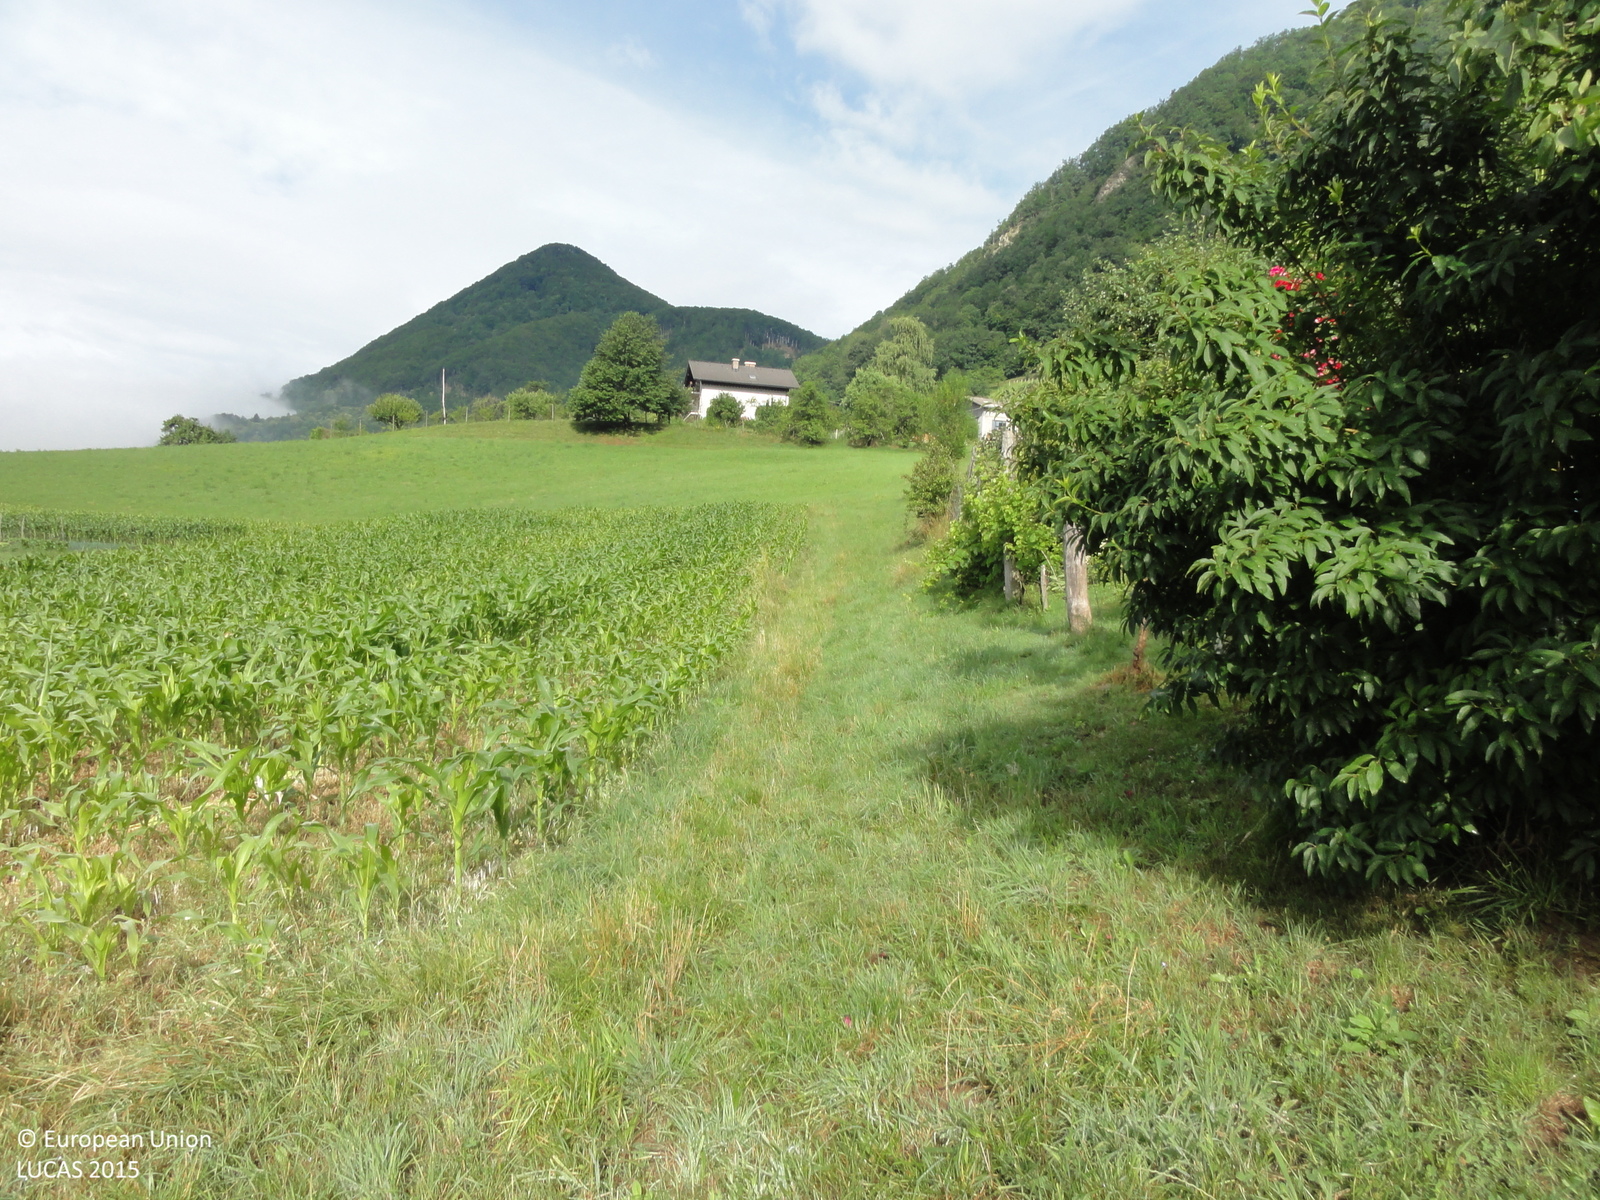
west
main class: Grassland
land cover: Grassland without tree/shrub cover
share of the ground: > 75 %
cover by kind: herbaceous plants 100 %
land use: Agriculture (excluding fallow land and kitchen gardens)
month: June
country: SI
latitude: 46.2675
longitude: 15.7726
